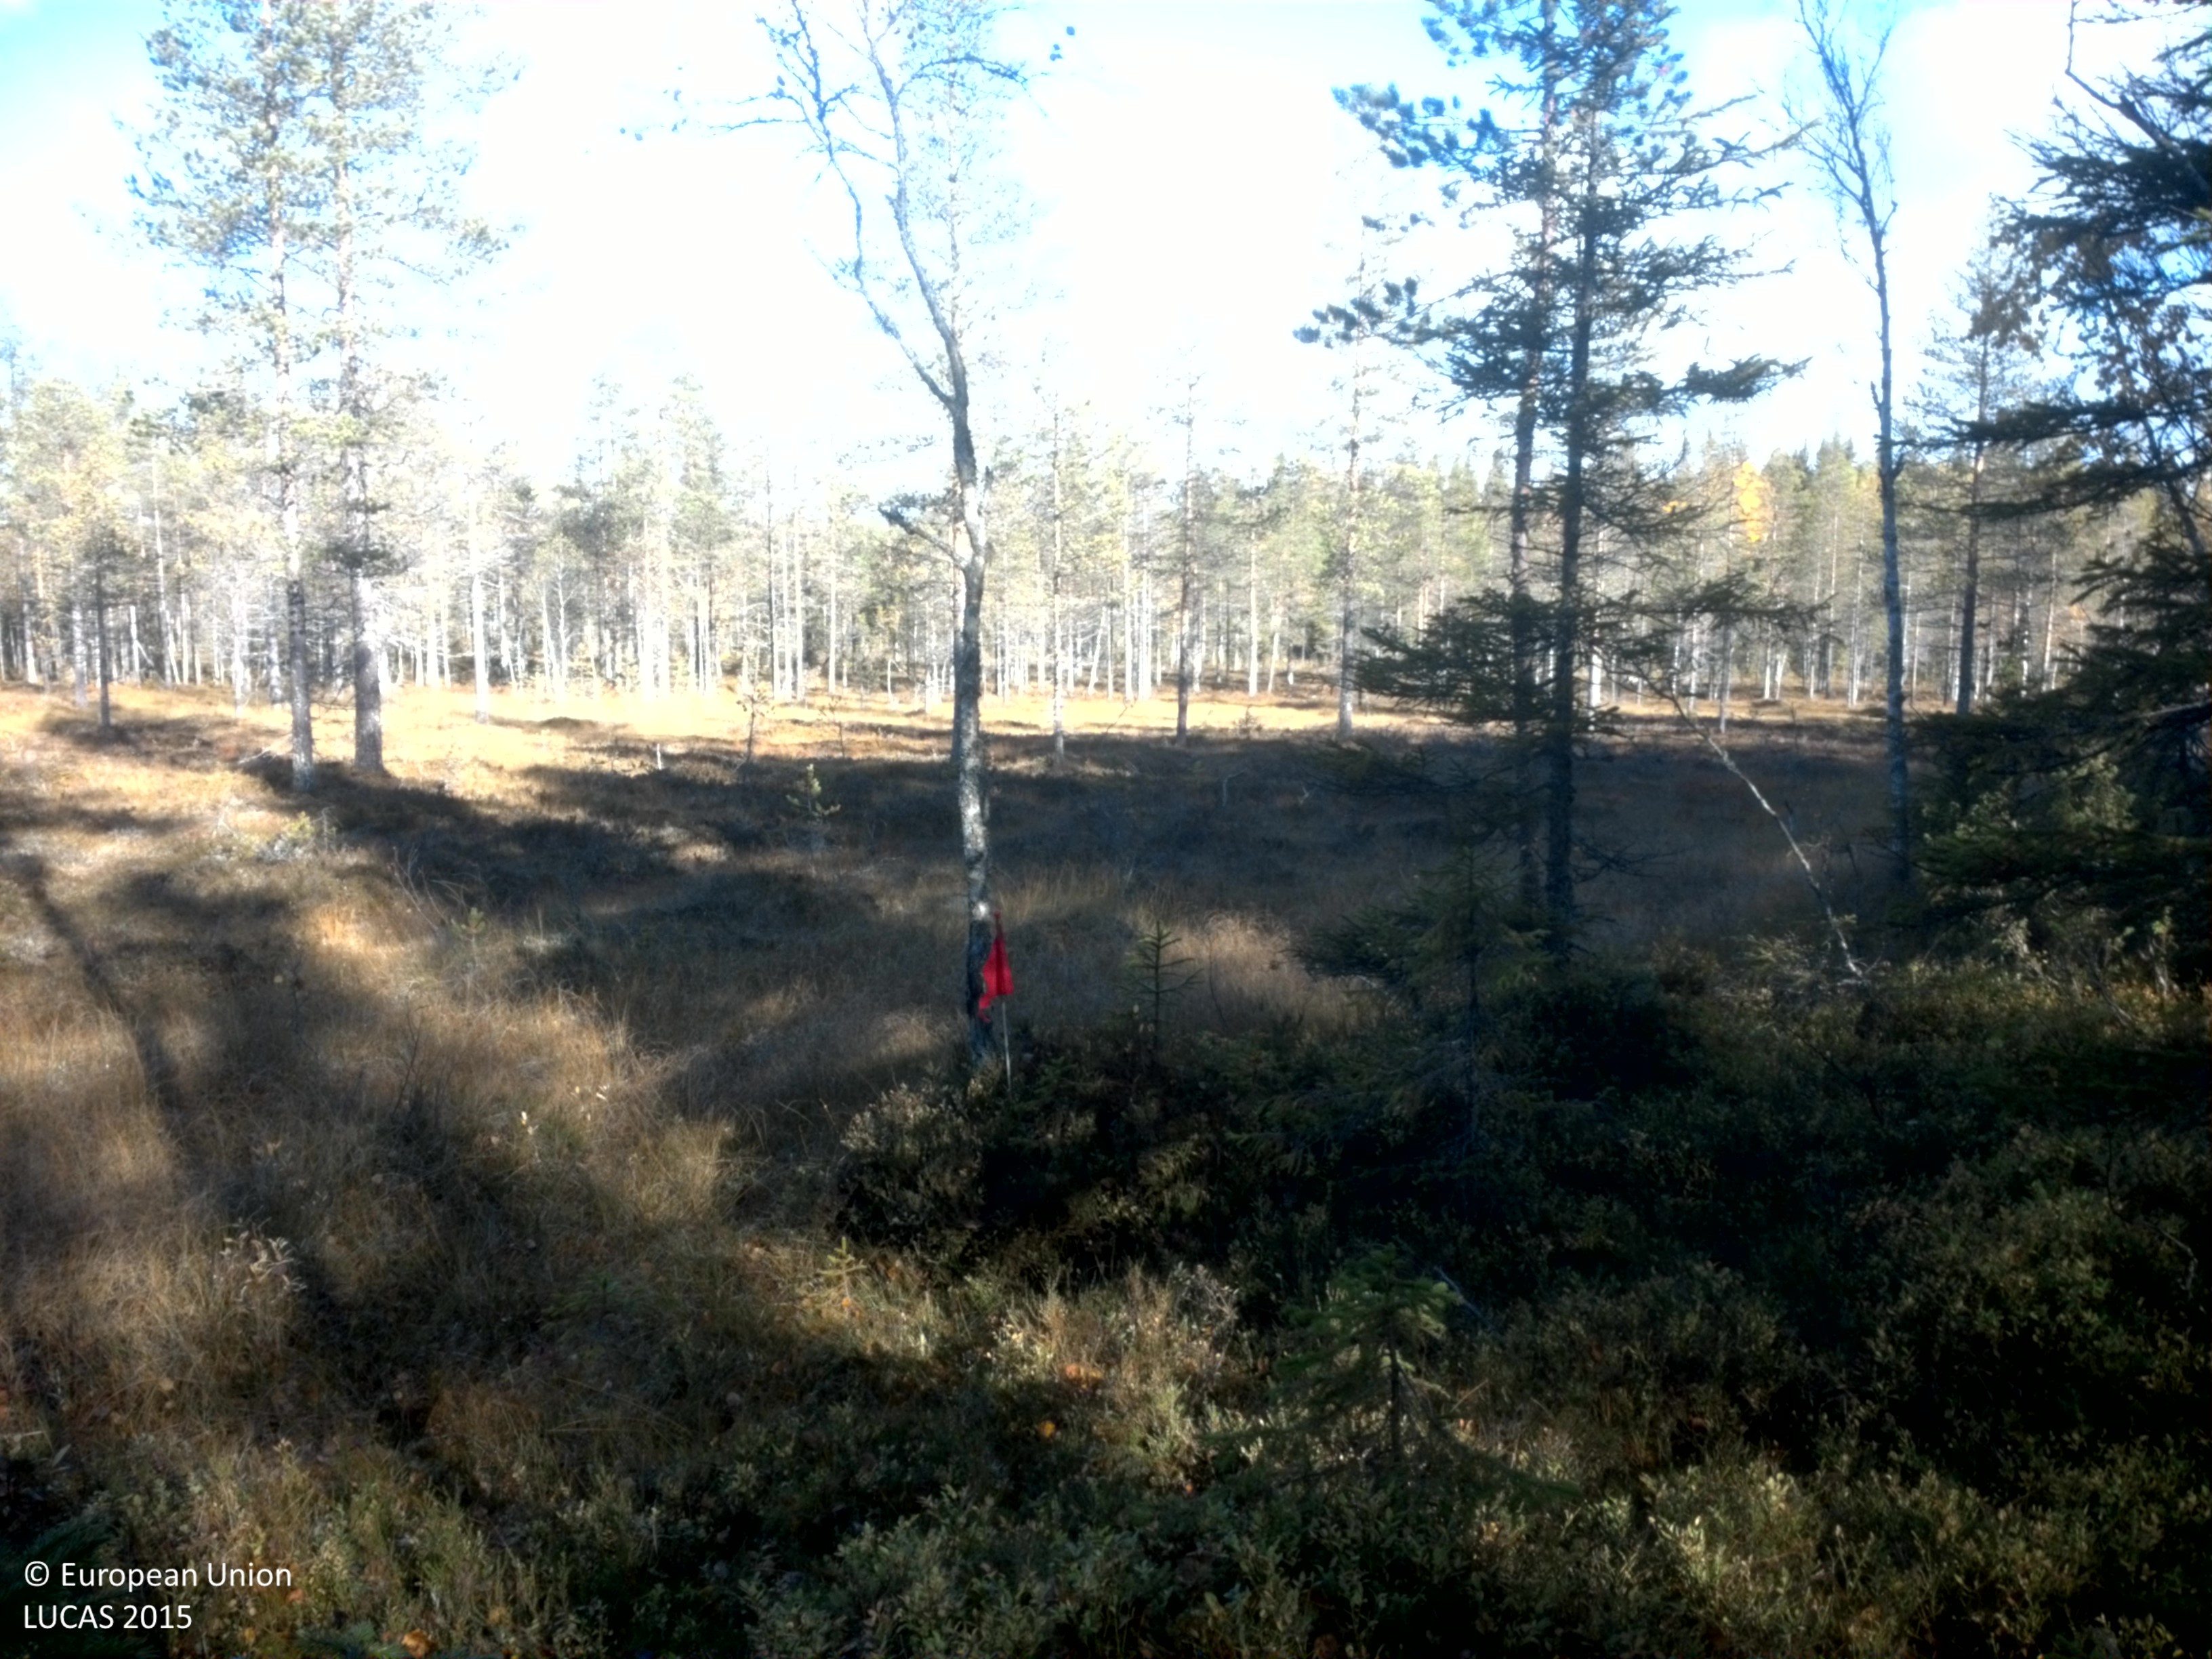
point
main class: Woodland
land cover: Pine dominated coniferous woodland
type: boreal forest
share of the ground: 10 - 25 %
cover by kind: shrubs 40 %, herbaceous plants 35 %, lichens and mosses 15 %, coniferous forest trees 10 %
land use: Semi-natural and natural areas not in use
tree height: > 5 m
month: September
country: SE
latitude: 64.2675
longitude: 19.9467
